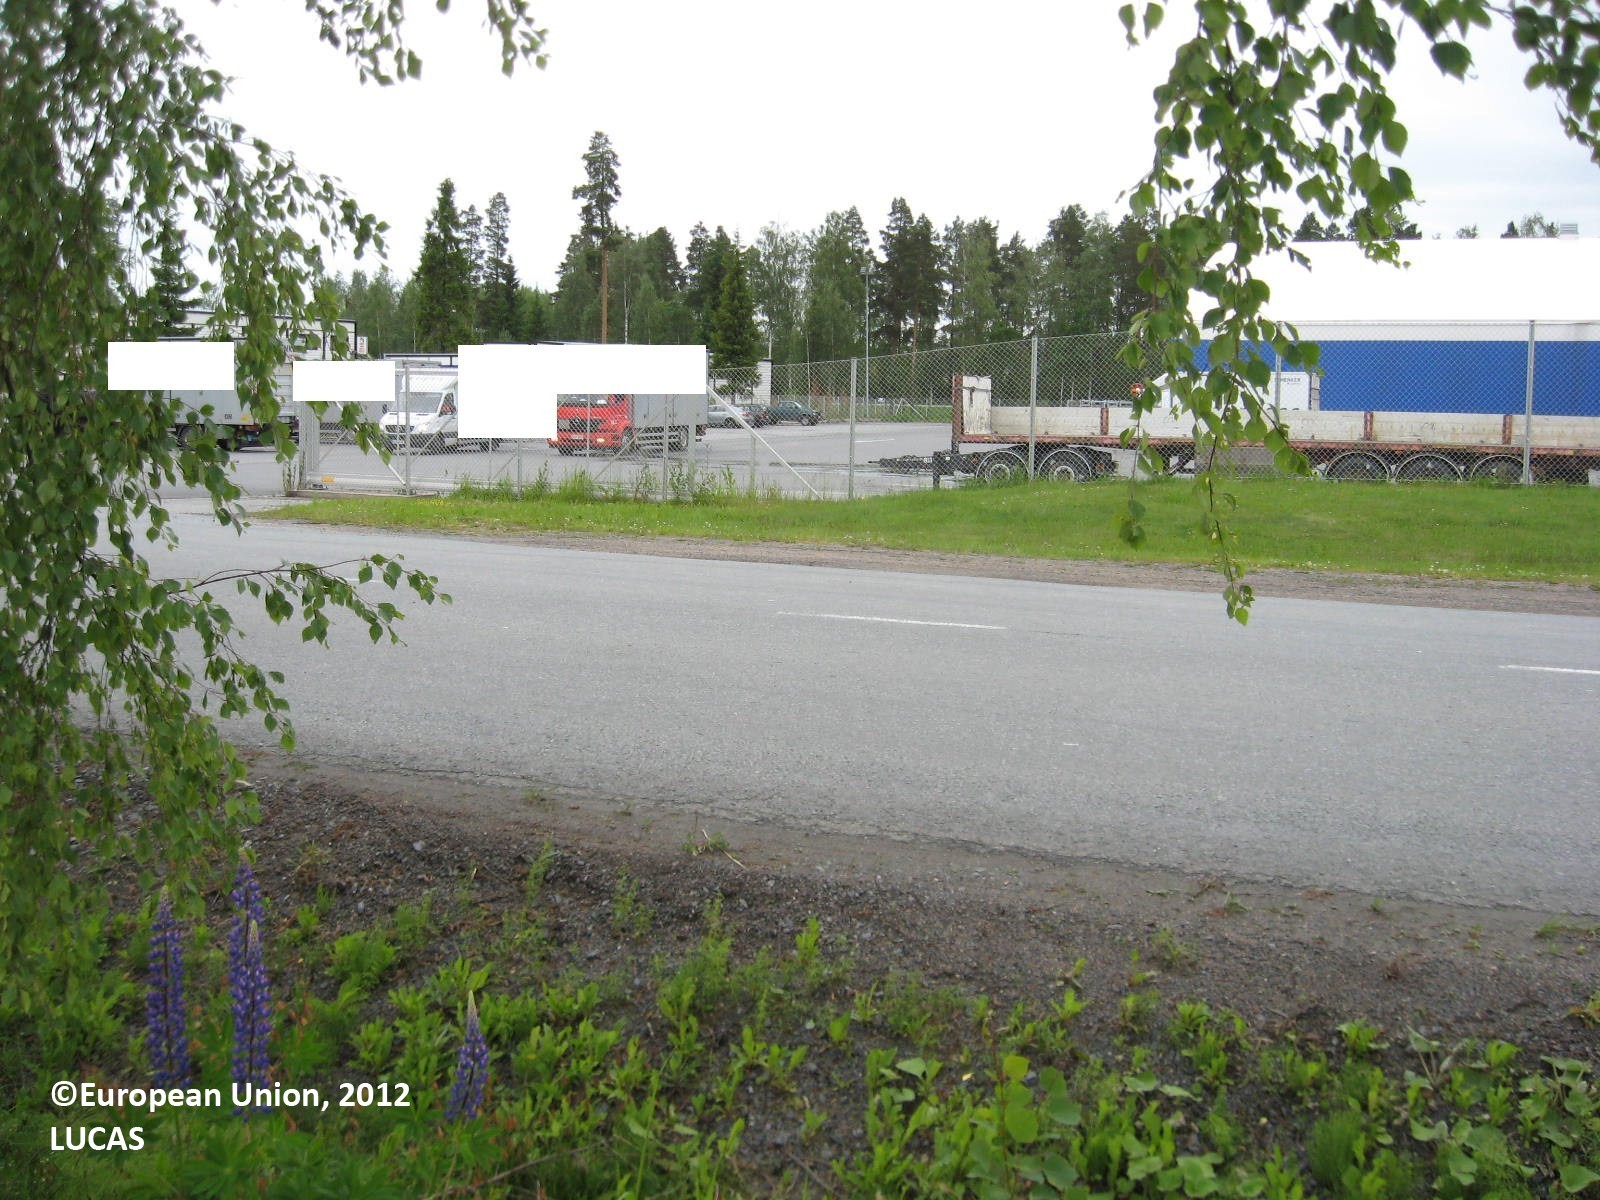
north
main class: Woodland
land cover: Broadleaved woodland
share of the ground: > 75 %
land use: Commerce, finance, business
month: June
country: FI
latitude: 62.7875
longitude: 22.8980
